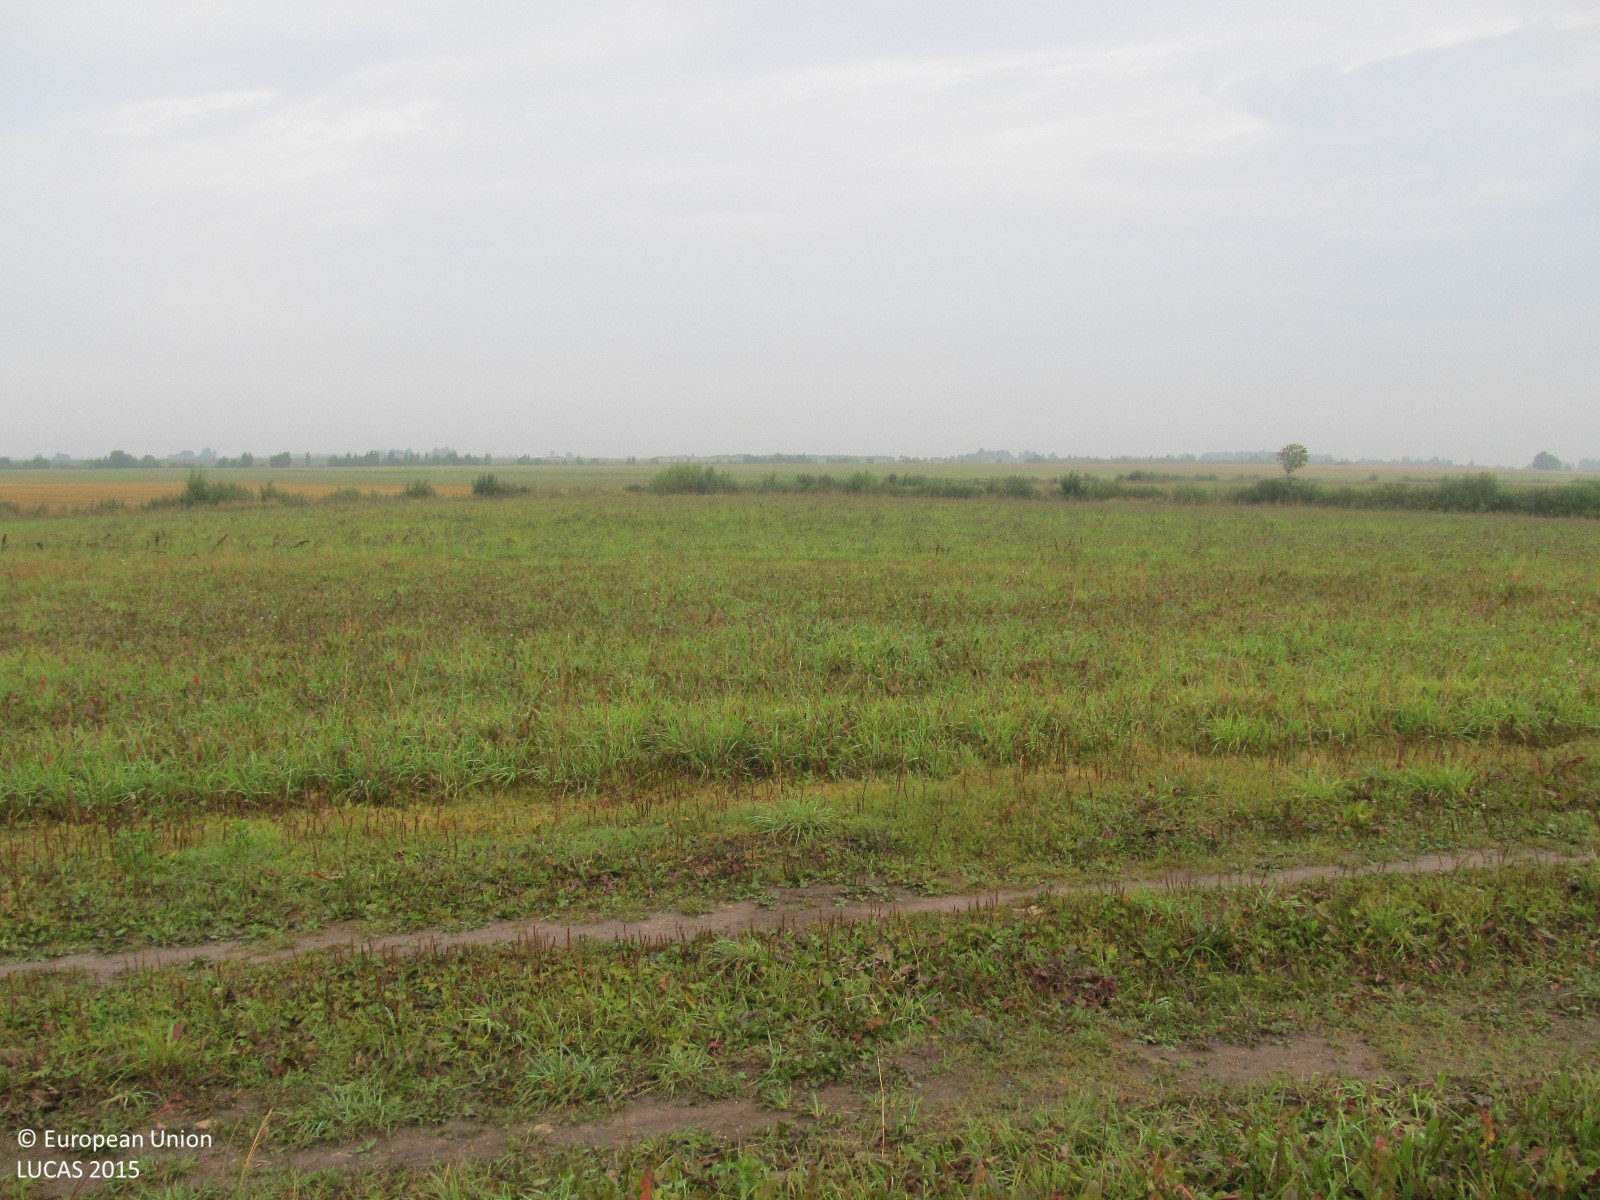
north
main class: Grassland
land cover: Grassland without tree/shrub cover
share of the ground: > 75 %
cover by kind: herbaceous plants 100 %
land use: Agriculture (excluding fallow land and kitchen gardens)
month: September
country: LT
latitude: 56.0747
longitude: 23.1314
